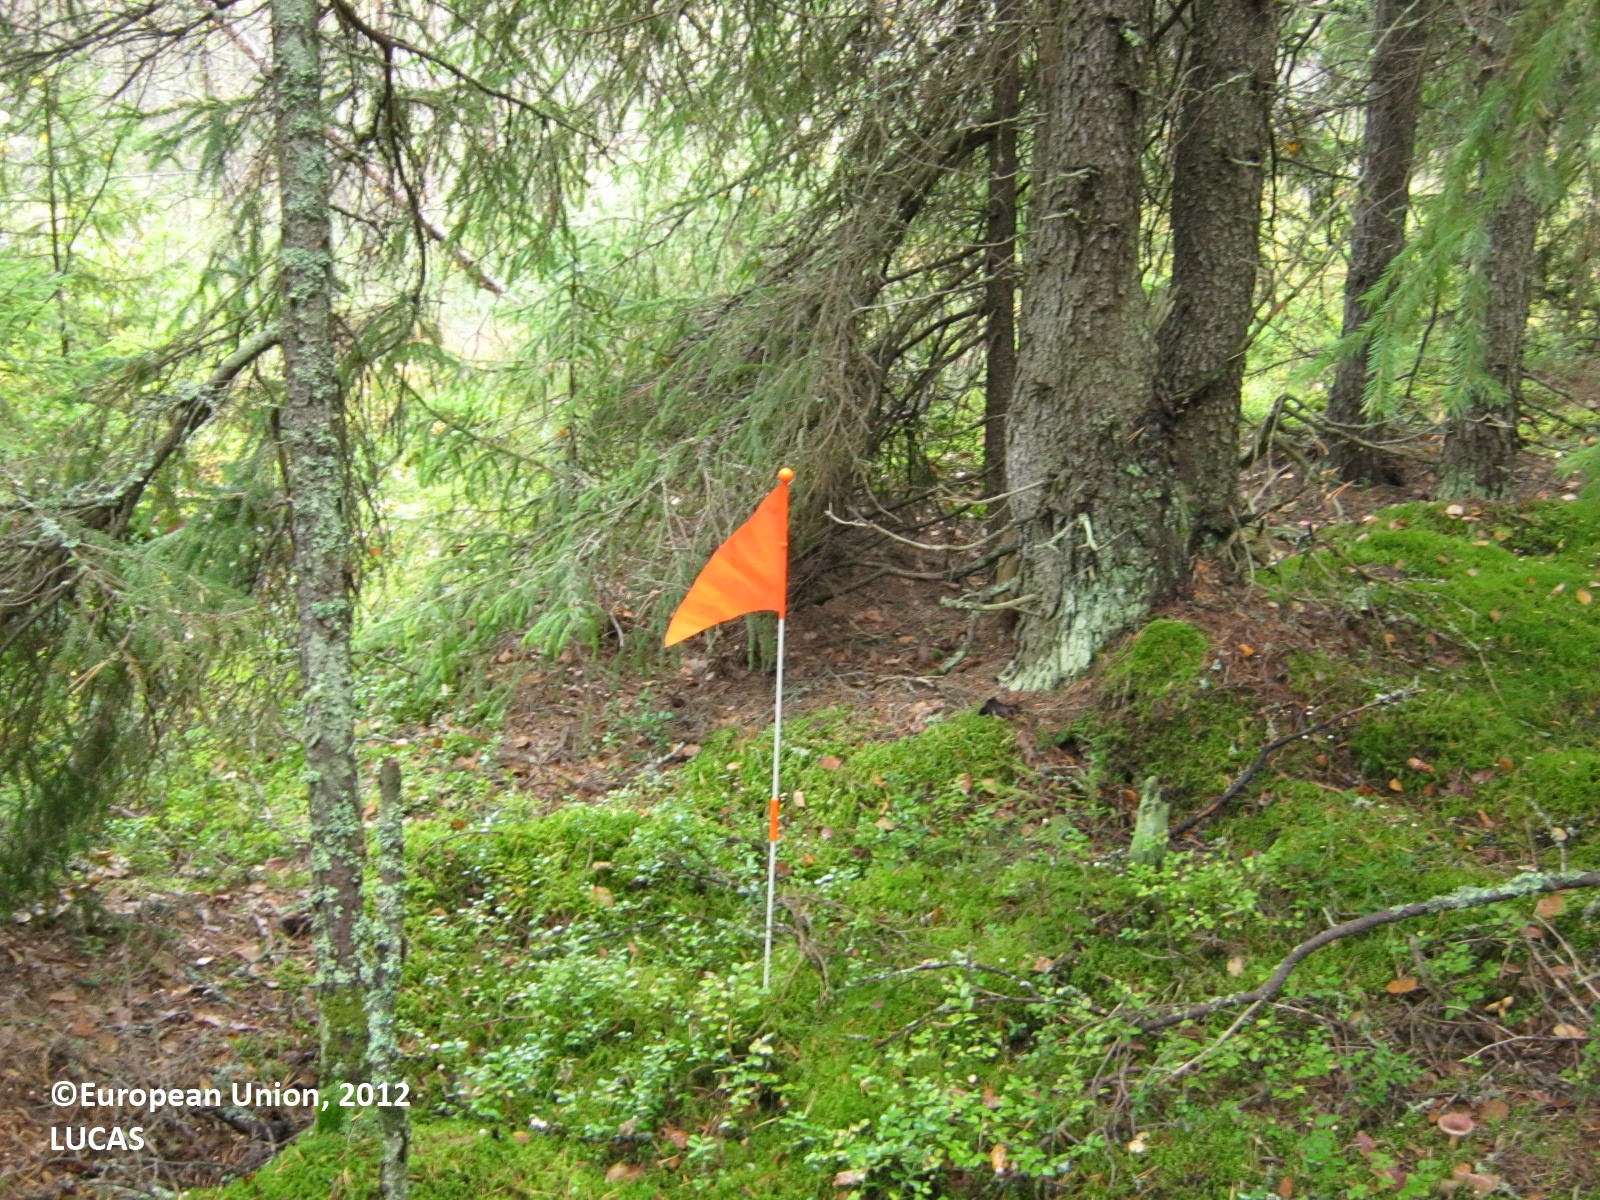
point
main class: Woodland
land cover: Spruce dominated coniferous woodland
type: boreal forest
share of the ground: 50 - 75 %
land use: Forestry
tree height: > 5 m
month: September
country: FI
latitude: 60.8808
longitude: 27.5570
